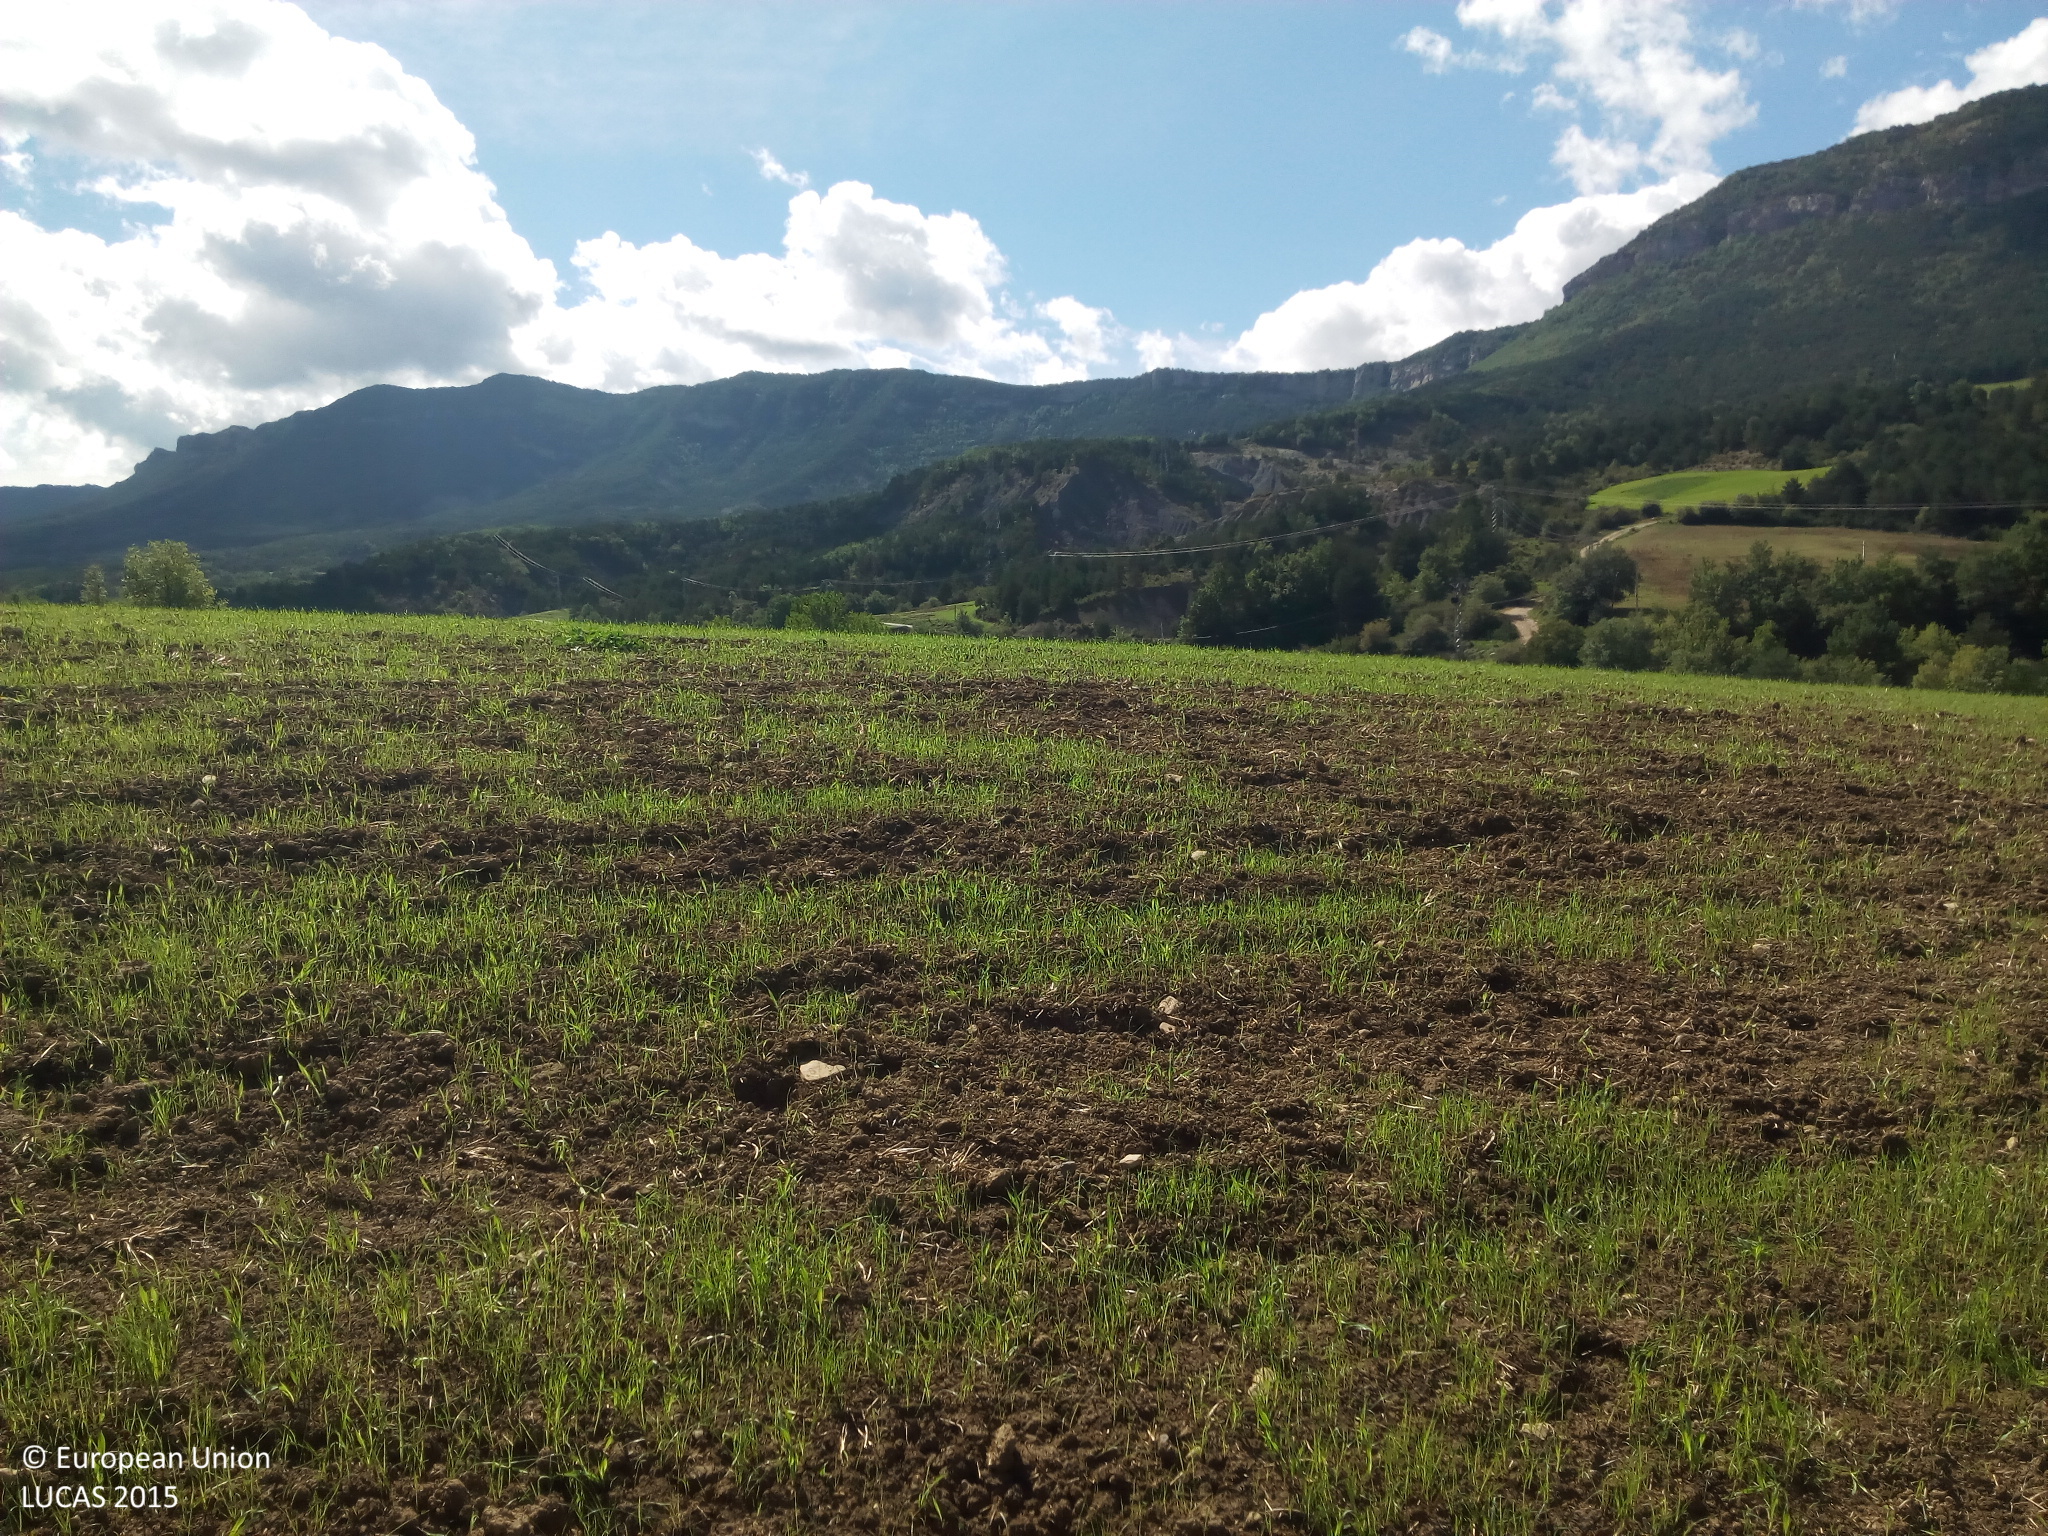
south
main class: Grassland
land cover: Spontaneously vegetated surfaces
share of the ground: > 75 %
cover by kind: herbaceous plants 75 %, unconsolidated bare surface 25 %
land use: Fallow land
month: September
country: ES
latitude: 42.4011
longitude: 0.4435
